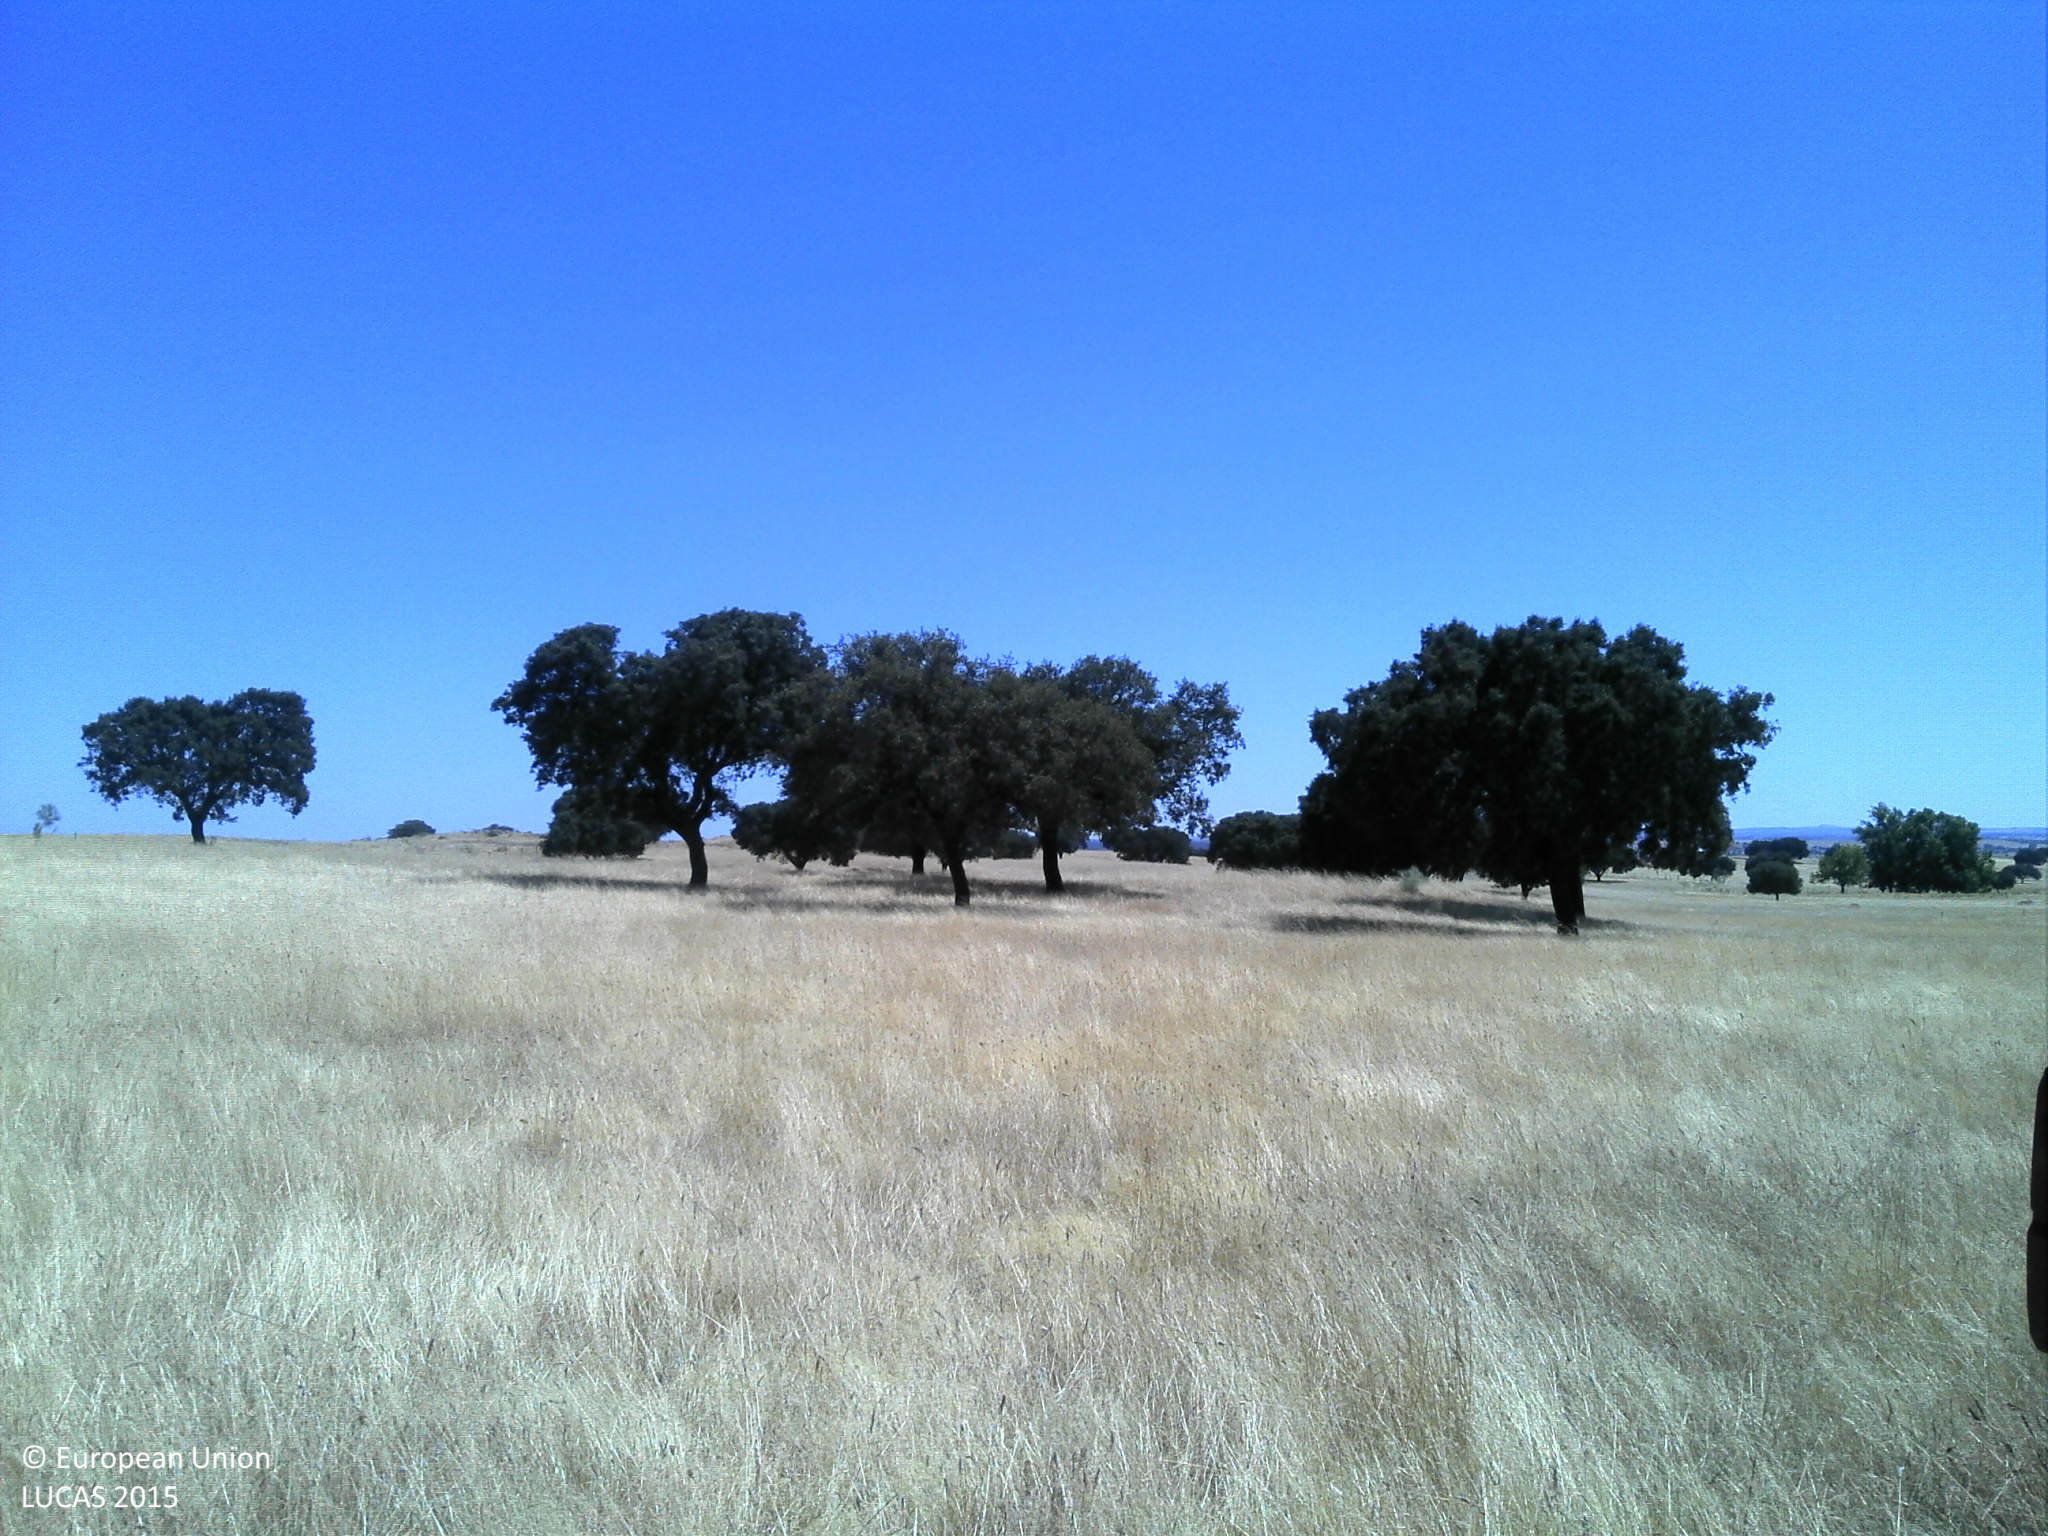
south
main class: Grassland
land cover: Grassland with sparse tree/shrub cover
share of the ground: > 75 %
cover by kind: herbaceous plants 75 %, unconsolidated bare surface 20 %, broadleaved forest trees 5 %
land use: Agriculture (excluding fallow land and kitchen gardens)
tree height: > 5 m
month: July
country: PT
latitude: 39.0947
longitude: -7.5575
